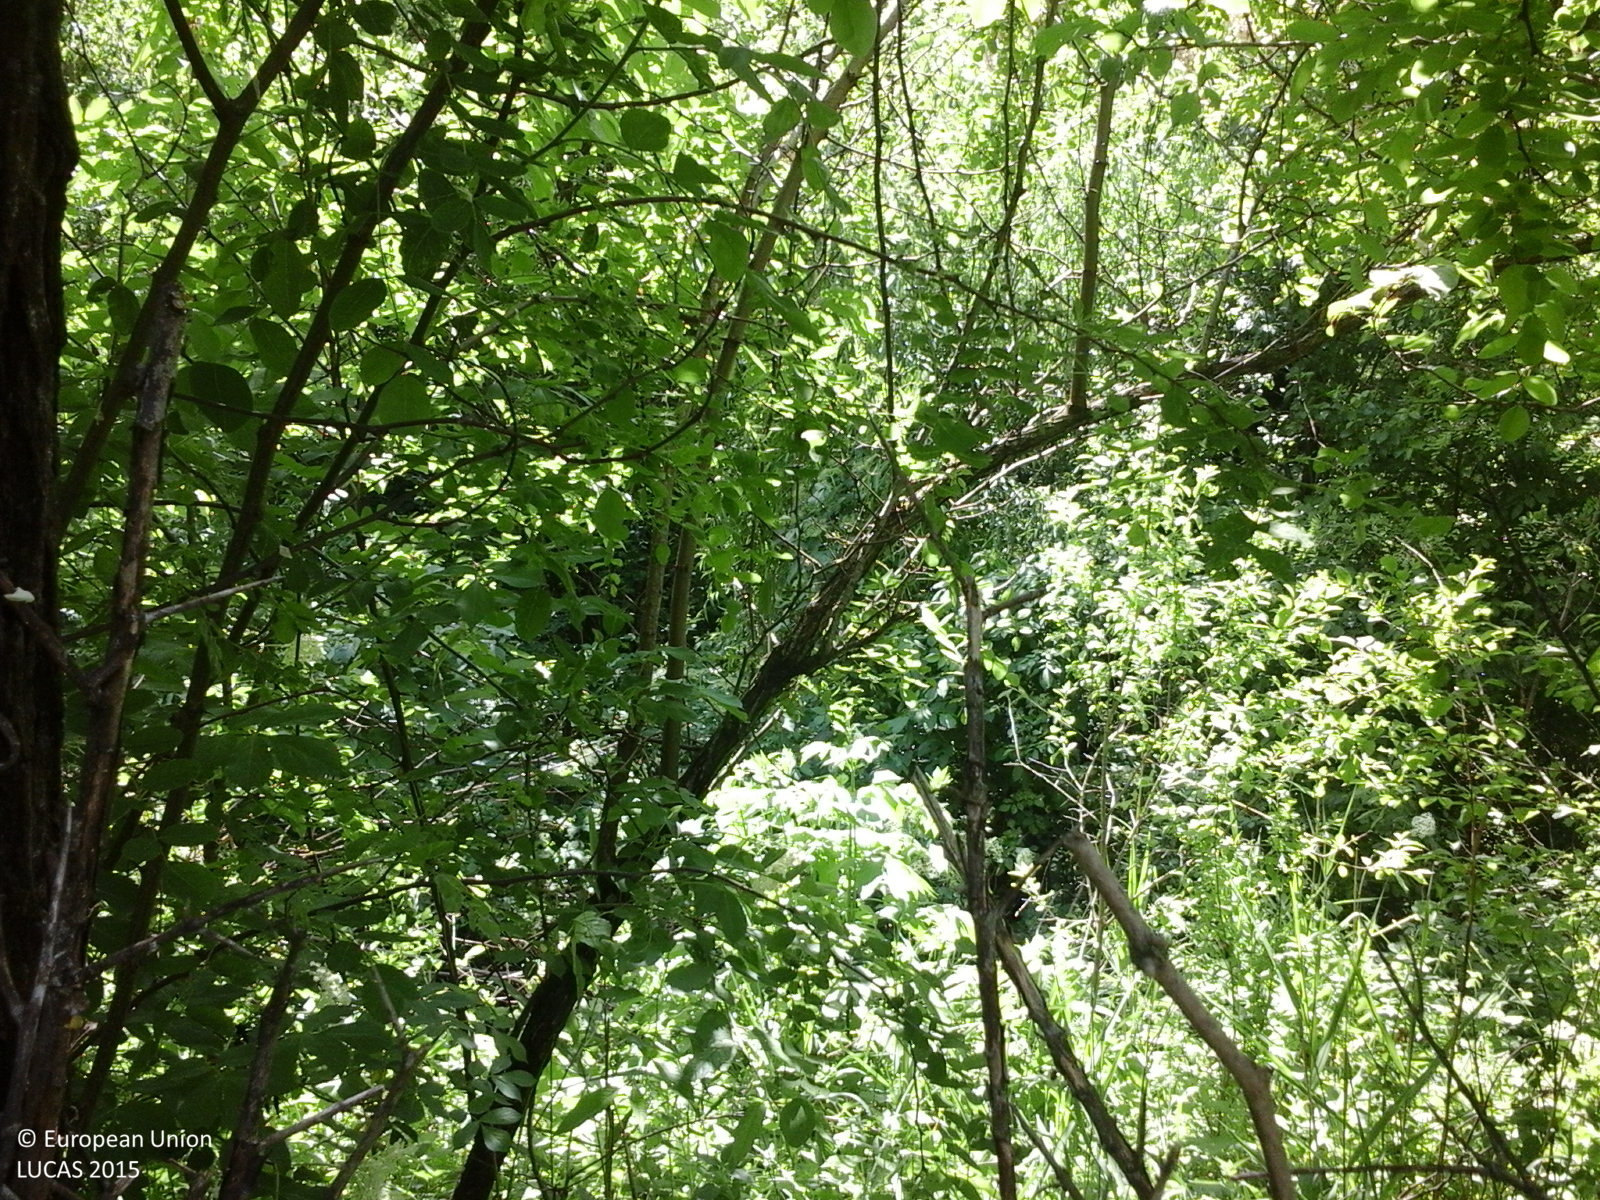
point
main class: Woodland
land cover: Broadleaved woodland
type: beech forest
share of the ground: > 75 %
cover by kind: broadleaved forest trees 90 %, shrubs 5 %, herbaceous plants 5 %
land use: Forestry
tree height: > 5 m
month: May
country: RO
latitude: 45.2338
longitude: 26.2032
